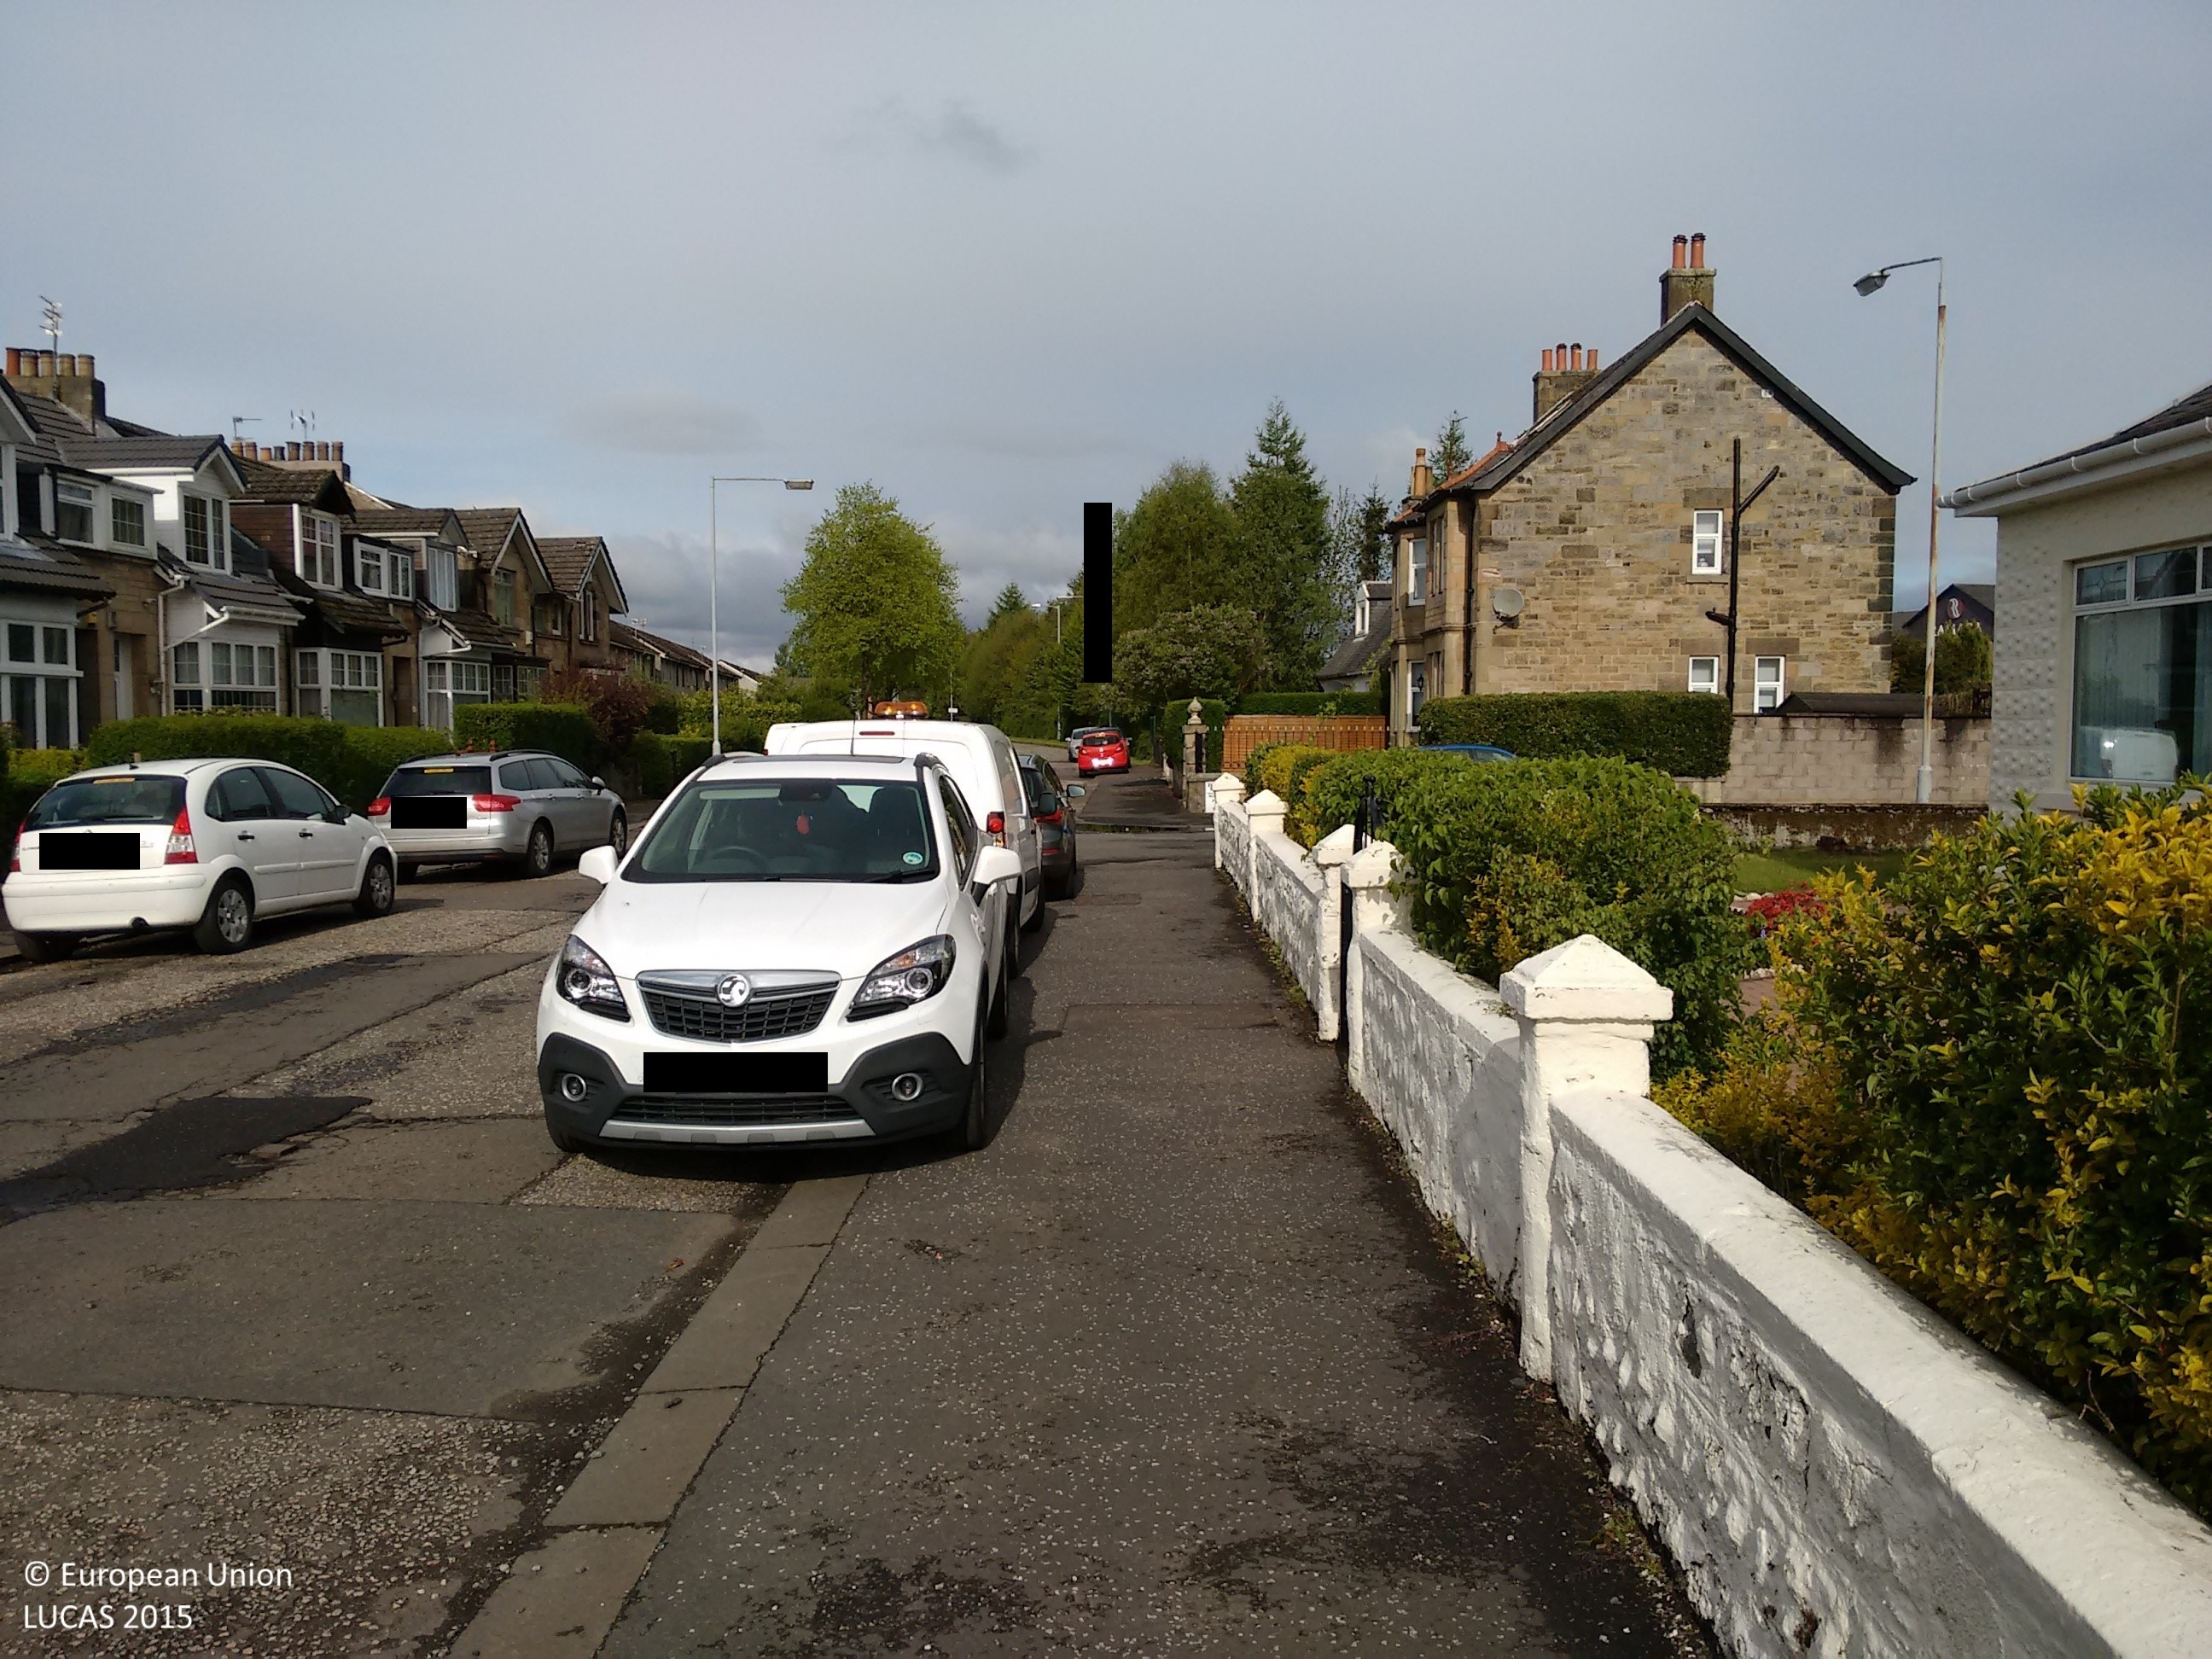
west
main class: Grassland
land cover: Grassland without tree/shrub cover
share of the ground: > 75 %
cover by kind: herbaceous plants 100 %
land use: Residential
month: May
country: GB
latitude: 55.8603
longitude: -4.4286
